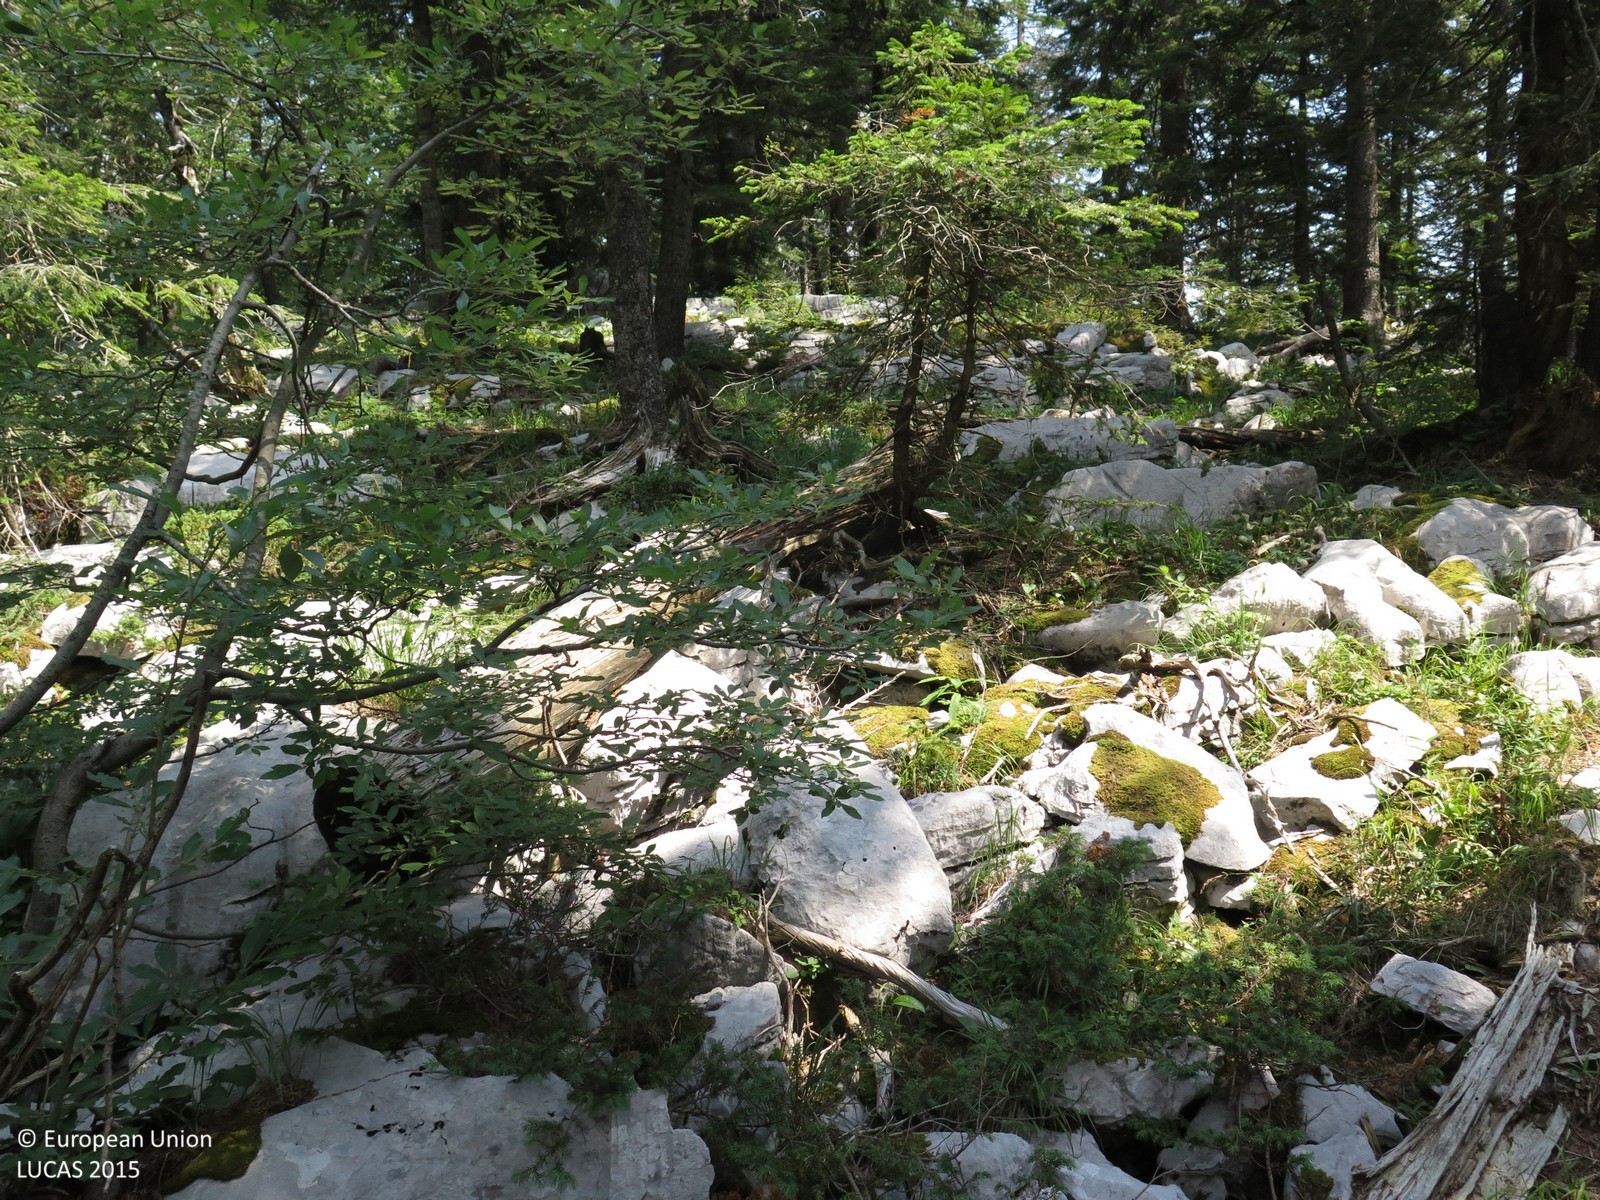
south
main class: Woodland
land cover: Other mixed woodland
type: coniferous forest of the mediterranean region
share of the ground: > 75 %
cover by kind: coniferous forest trees 70 %, broadleaved forest trees 25 %, unconsolidated bare surface 5 %
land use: Forestry
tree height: > 5 m
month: August
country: HR
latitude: 45.4960
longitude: 14.5638
